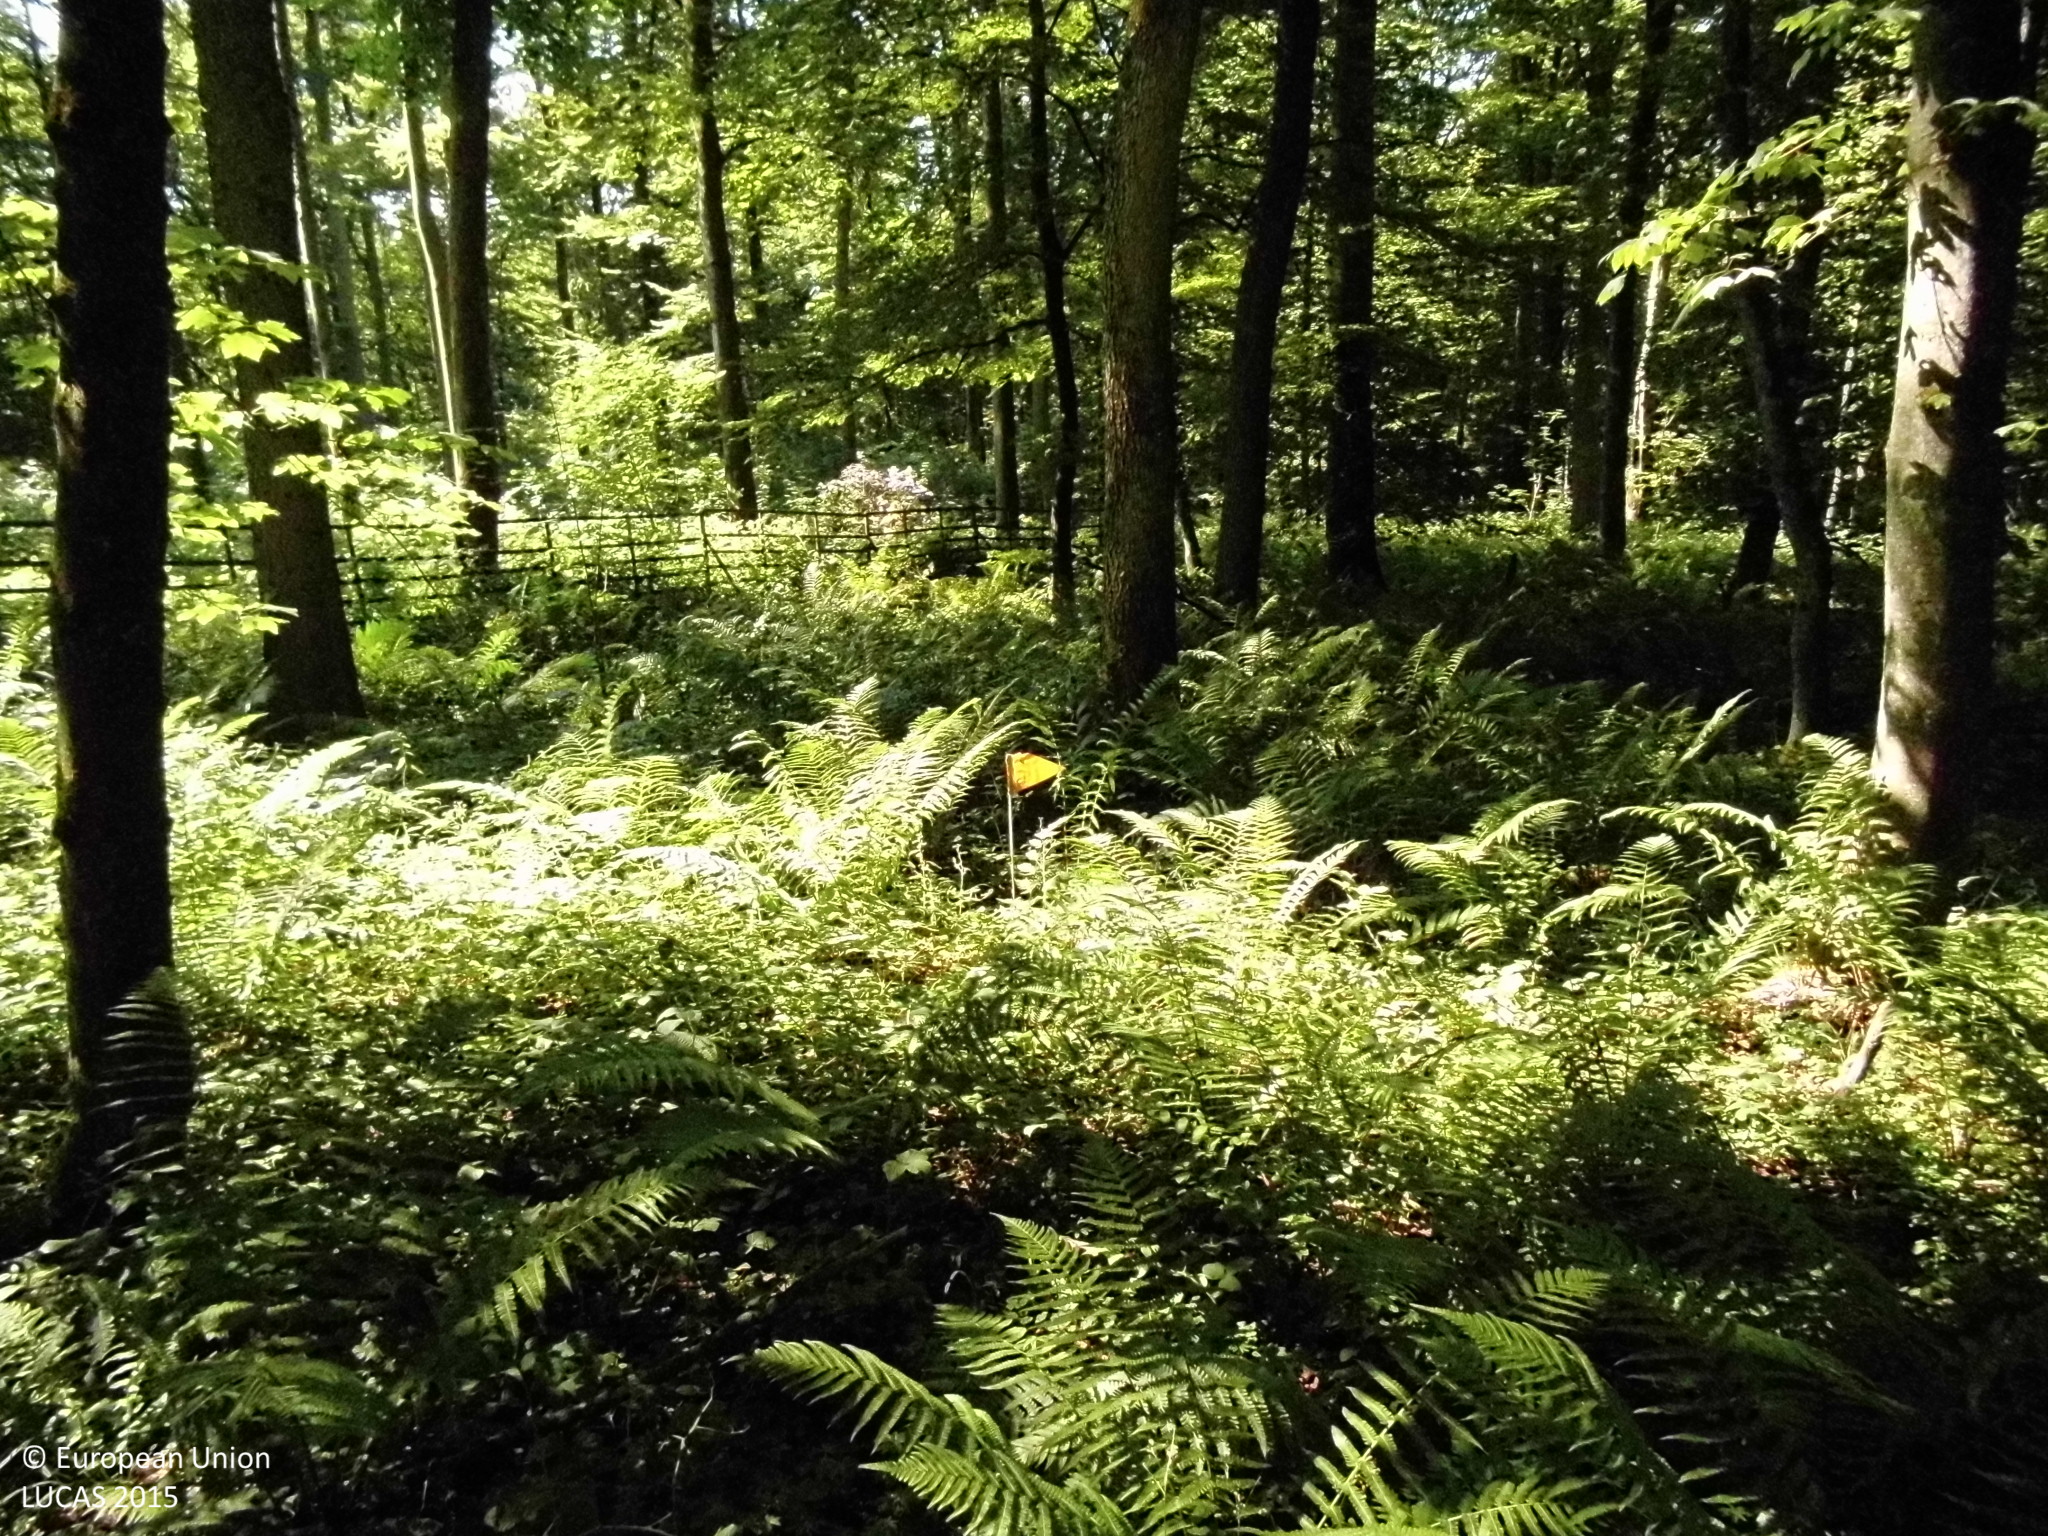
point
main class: Woodland
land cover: Broadleaved woodland
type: mesophytic deciduous forest
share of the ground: > 75 %
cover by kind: broadleaved forest trees 80 %, herbaceous plants 20 %
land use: Forestry
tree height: > 5 m
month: August
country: DE
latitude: 50.6539
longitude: 8.0909
